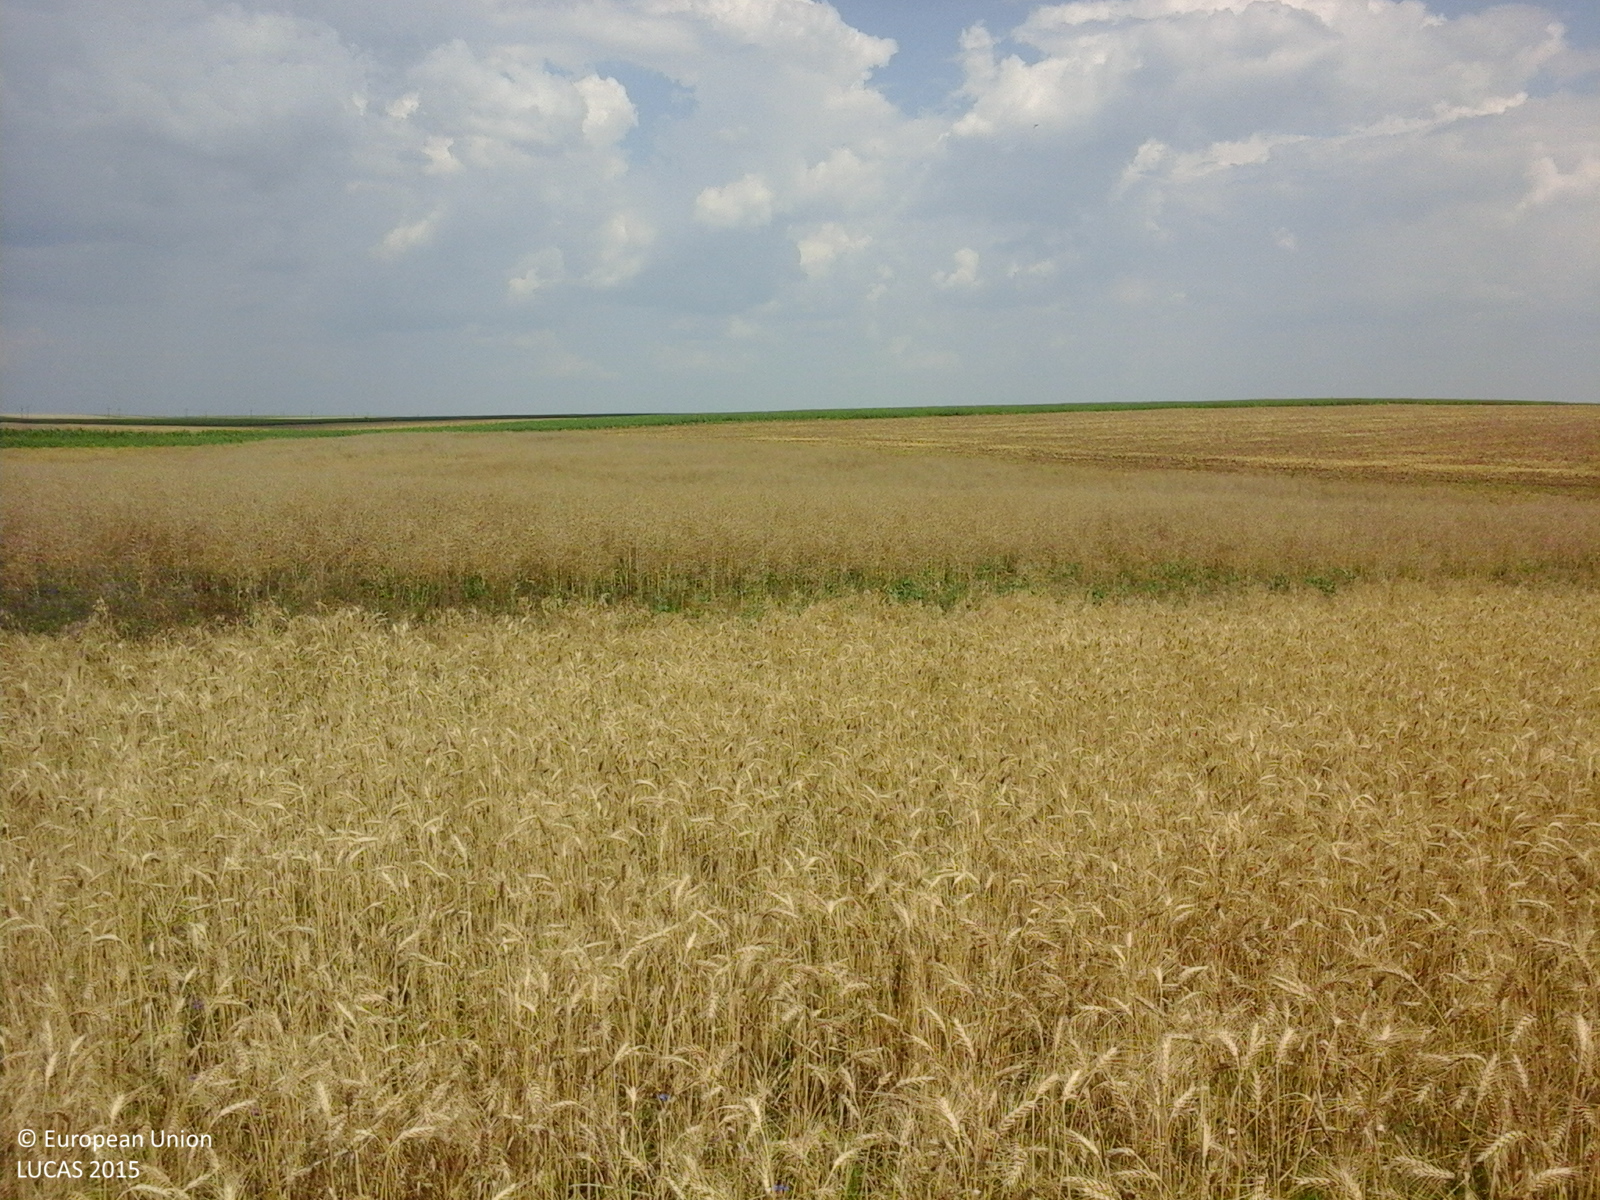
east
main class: Cropland
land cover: Common wheat
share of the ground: > 75 %
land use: Agriculture (excluding fallow land and kitchen gardens)
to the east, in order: Common wheat; Rape and turnip rape; Grass margins; Tracks; Grass margins; Common wheat; Sunflower; Grass margins; Common wheat
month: July
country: RO
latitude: 44.0199
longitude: 25.2641
